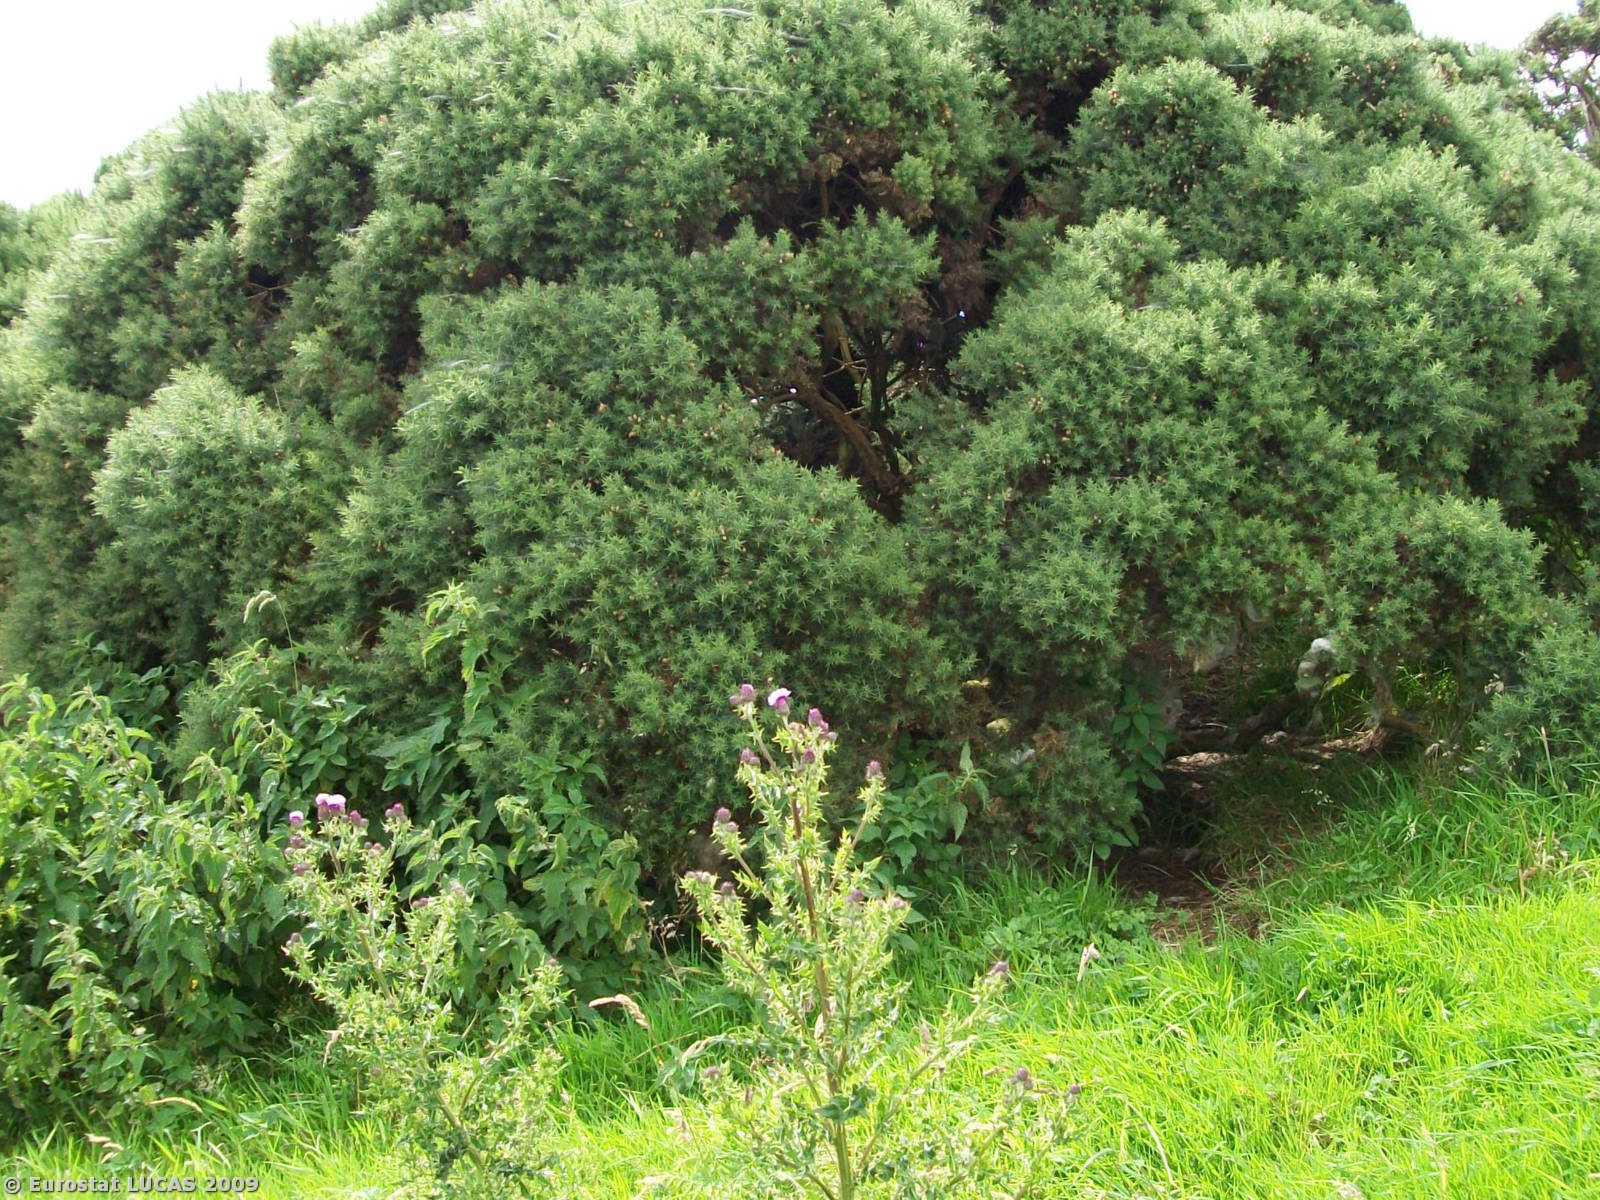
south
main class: Grassland
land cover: Grassland without tree/shrub cover
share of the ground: > 75 %
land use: Agriculture (excluding fallow land and kitchen gardens)
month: July
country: GB
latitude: 54.8929
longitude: -5.9000
